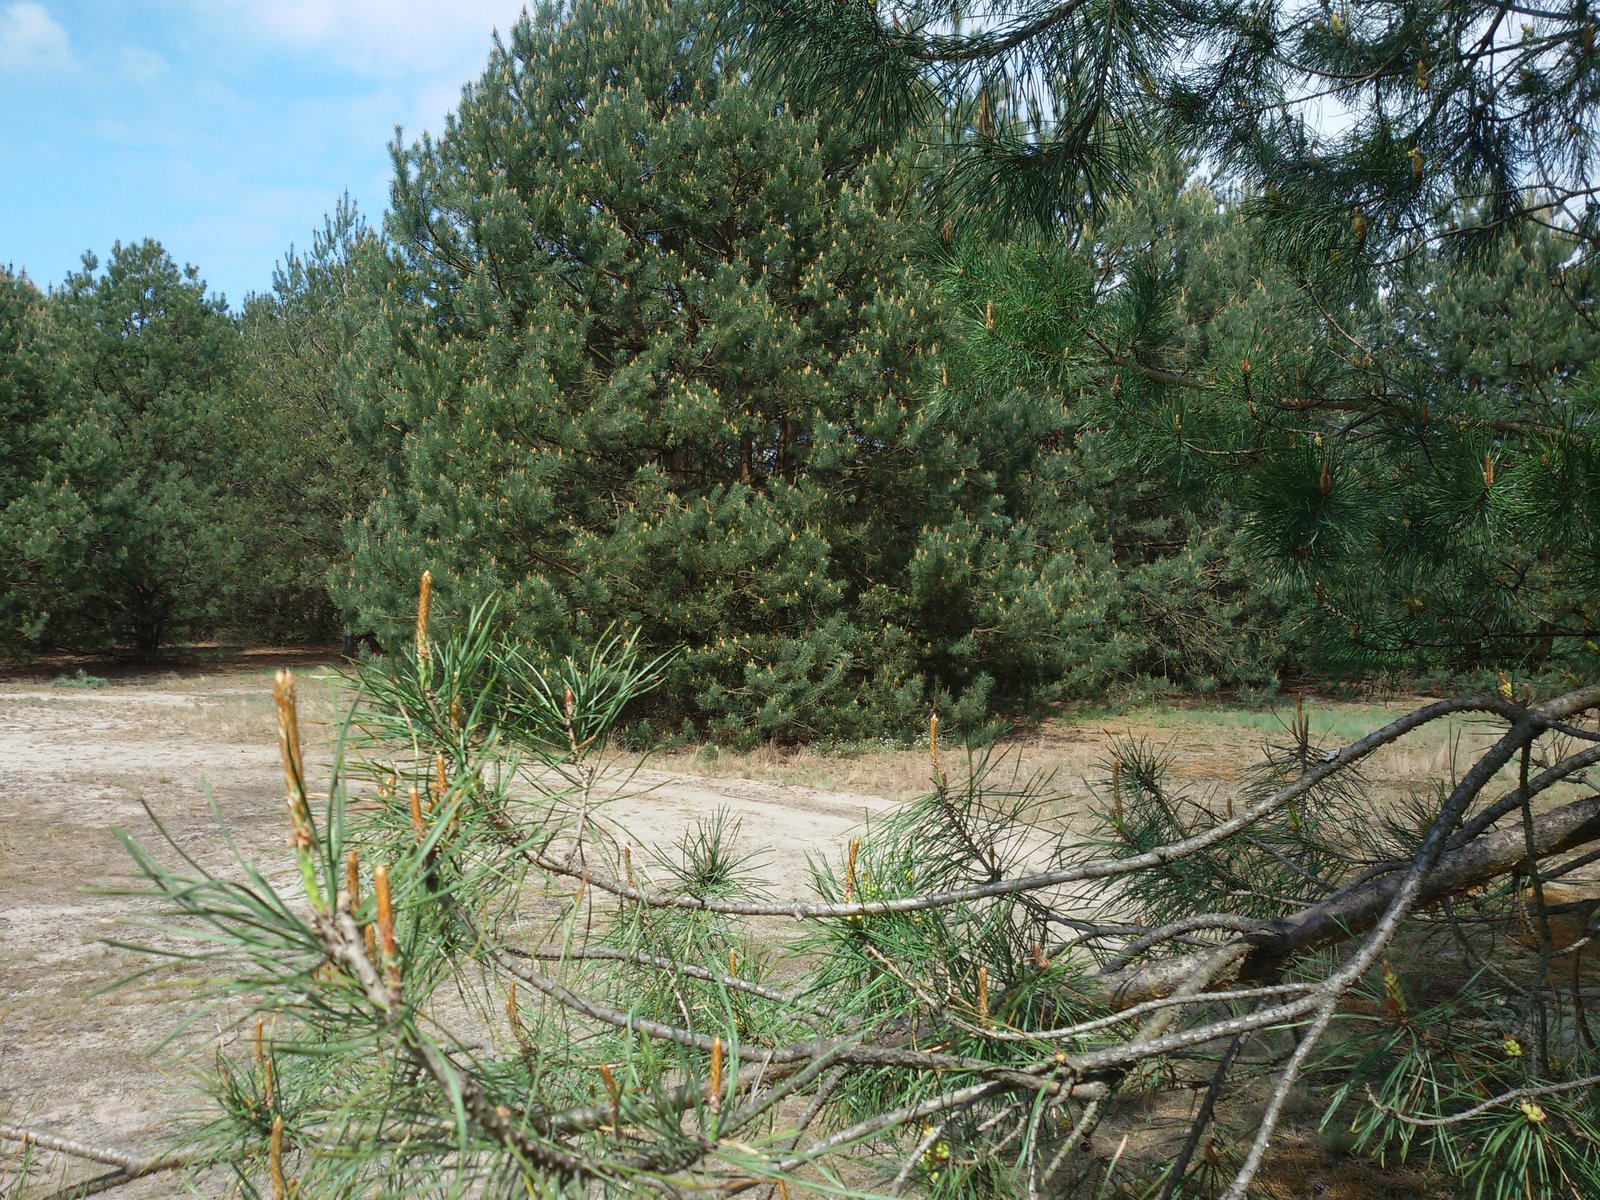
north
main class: Woodland
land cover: Pine dominated coniferous woodland
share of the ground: > 75 %
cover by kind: coniferous forest trees 75 %, lichens and mosses 15 %, unconsolidated bare surface 10 %
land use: Forestry
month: May
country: PL
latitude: 51.7410
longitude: 21.1543
